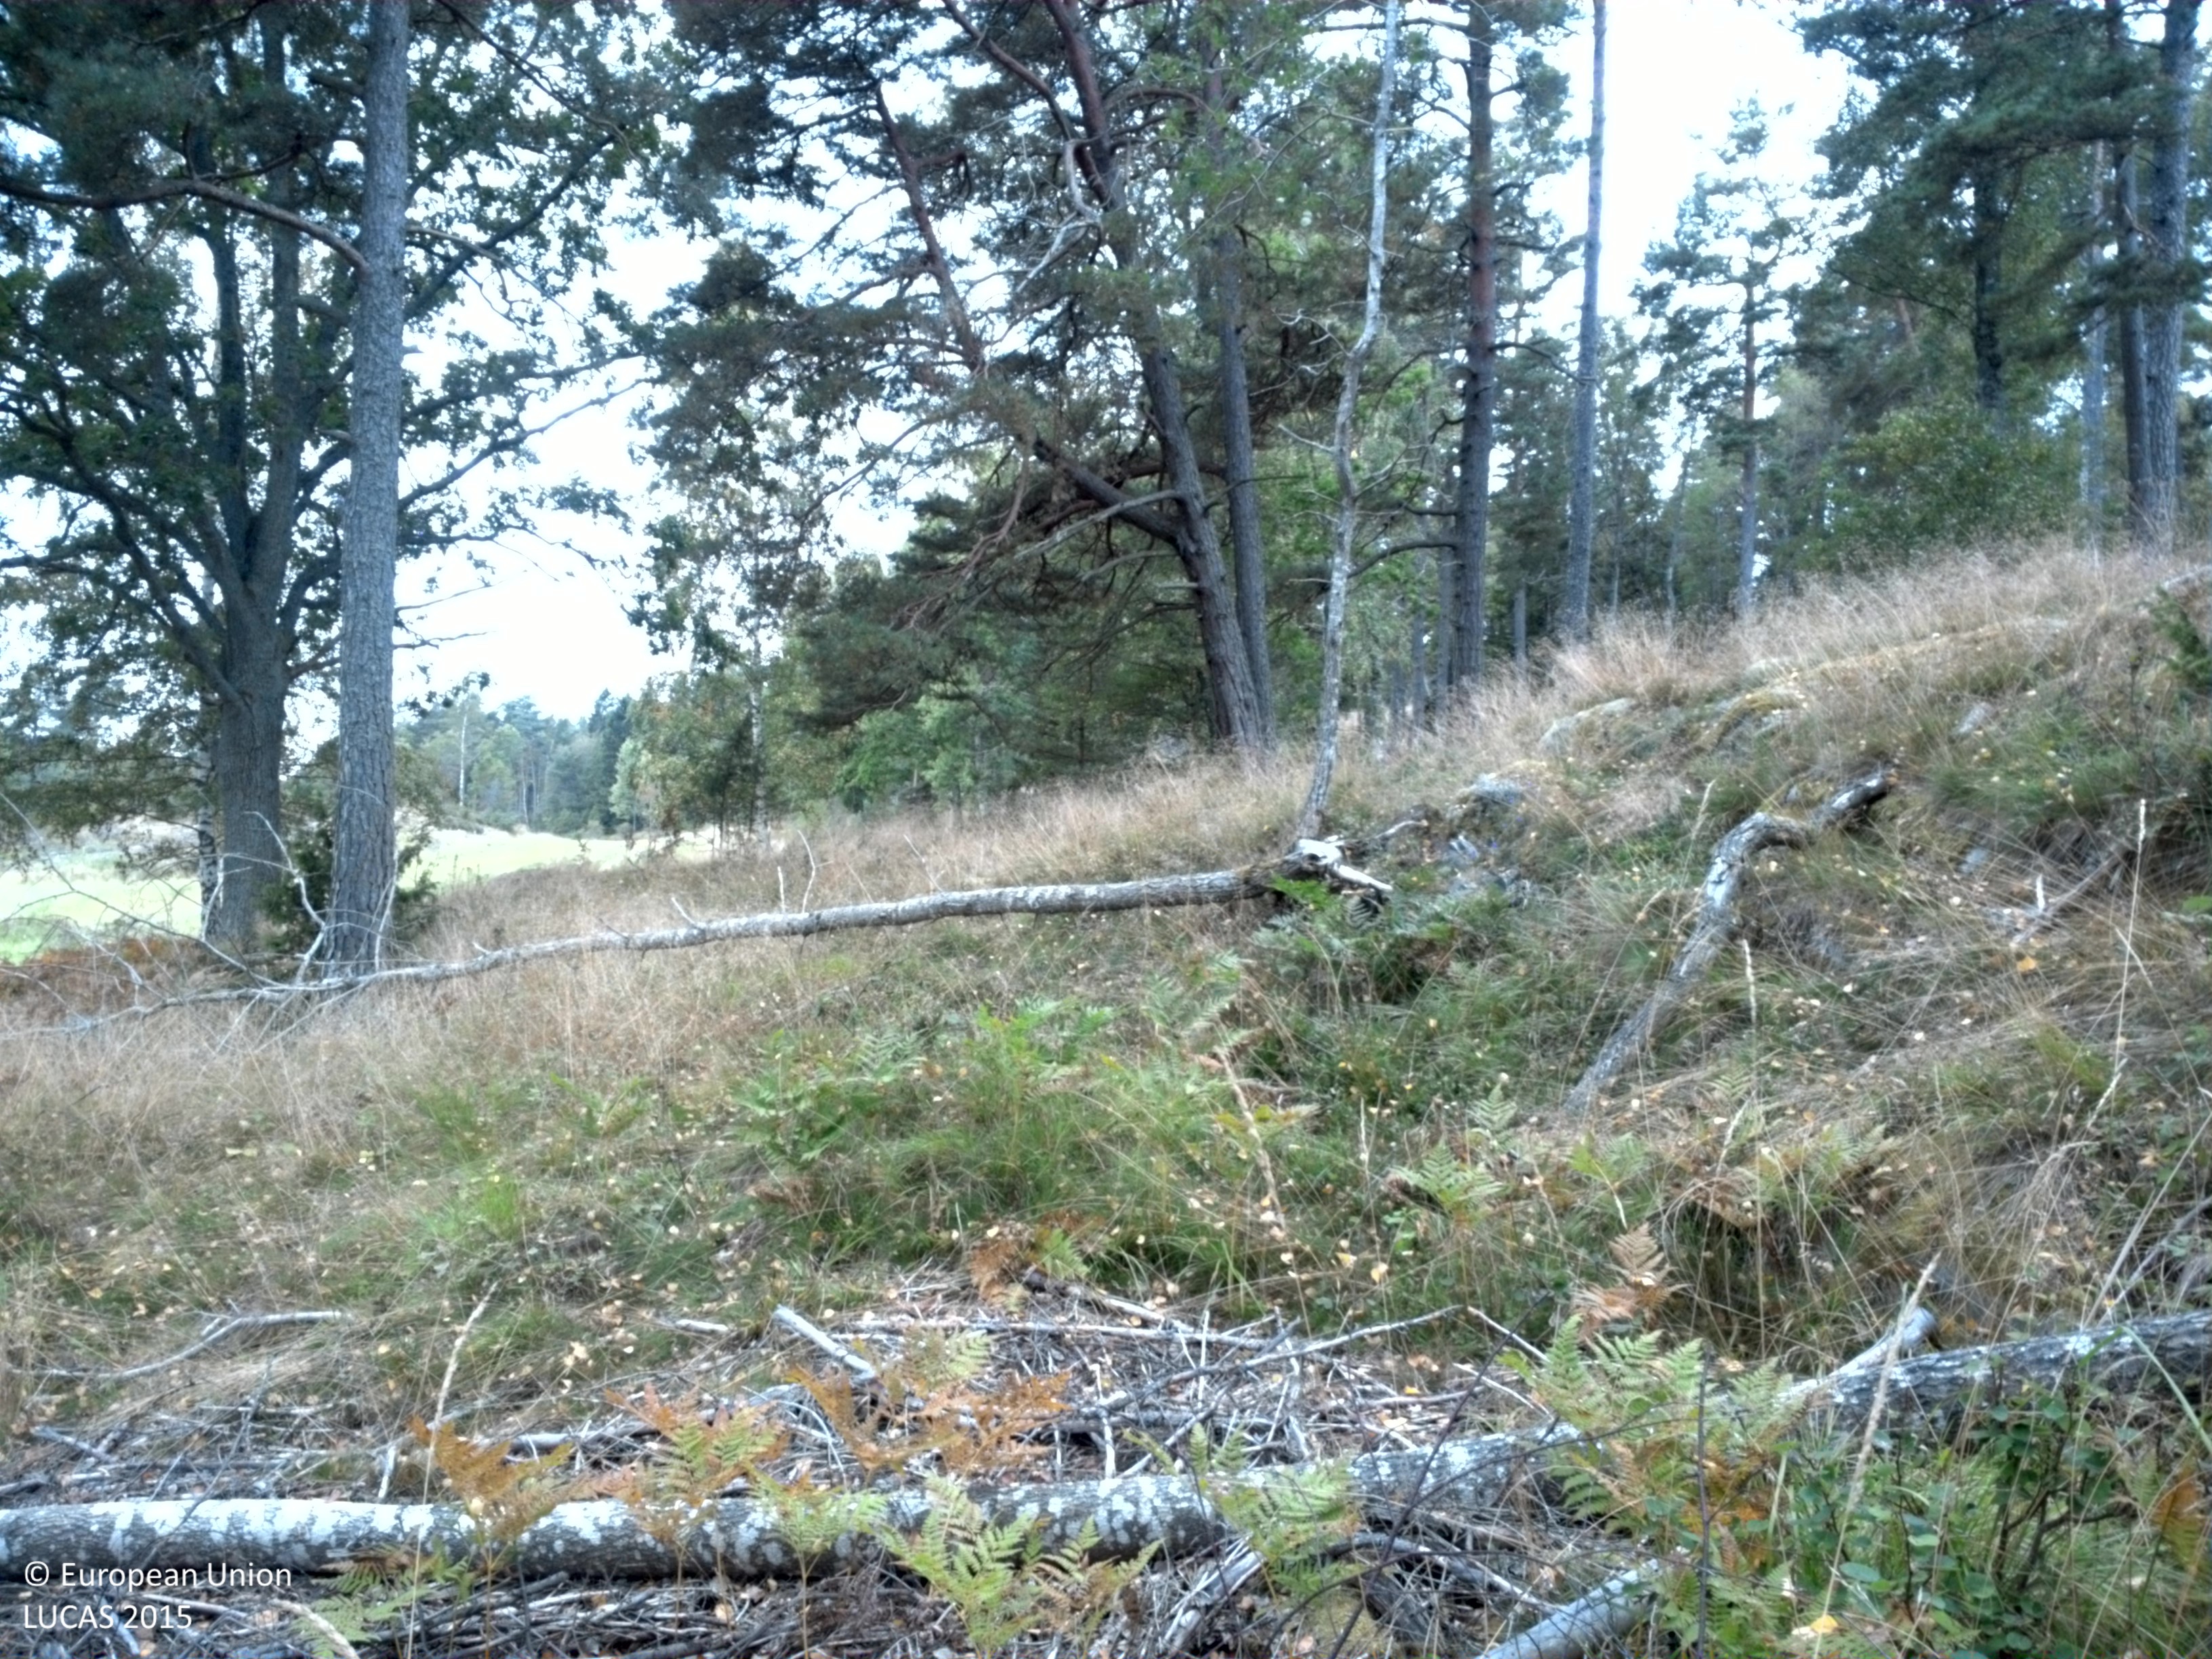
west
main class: Woodland
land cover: Broadleaved woodland
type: boreal forest
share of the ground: 50 - 75 %
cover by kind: broadleaved forest trees 50 %, herbaceous plants 40 %, coniferous forest trees 10 %
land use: Forestry
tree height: > 5 m
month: September
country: SE
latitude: 59.2953
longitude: 18.4109
